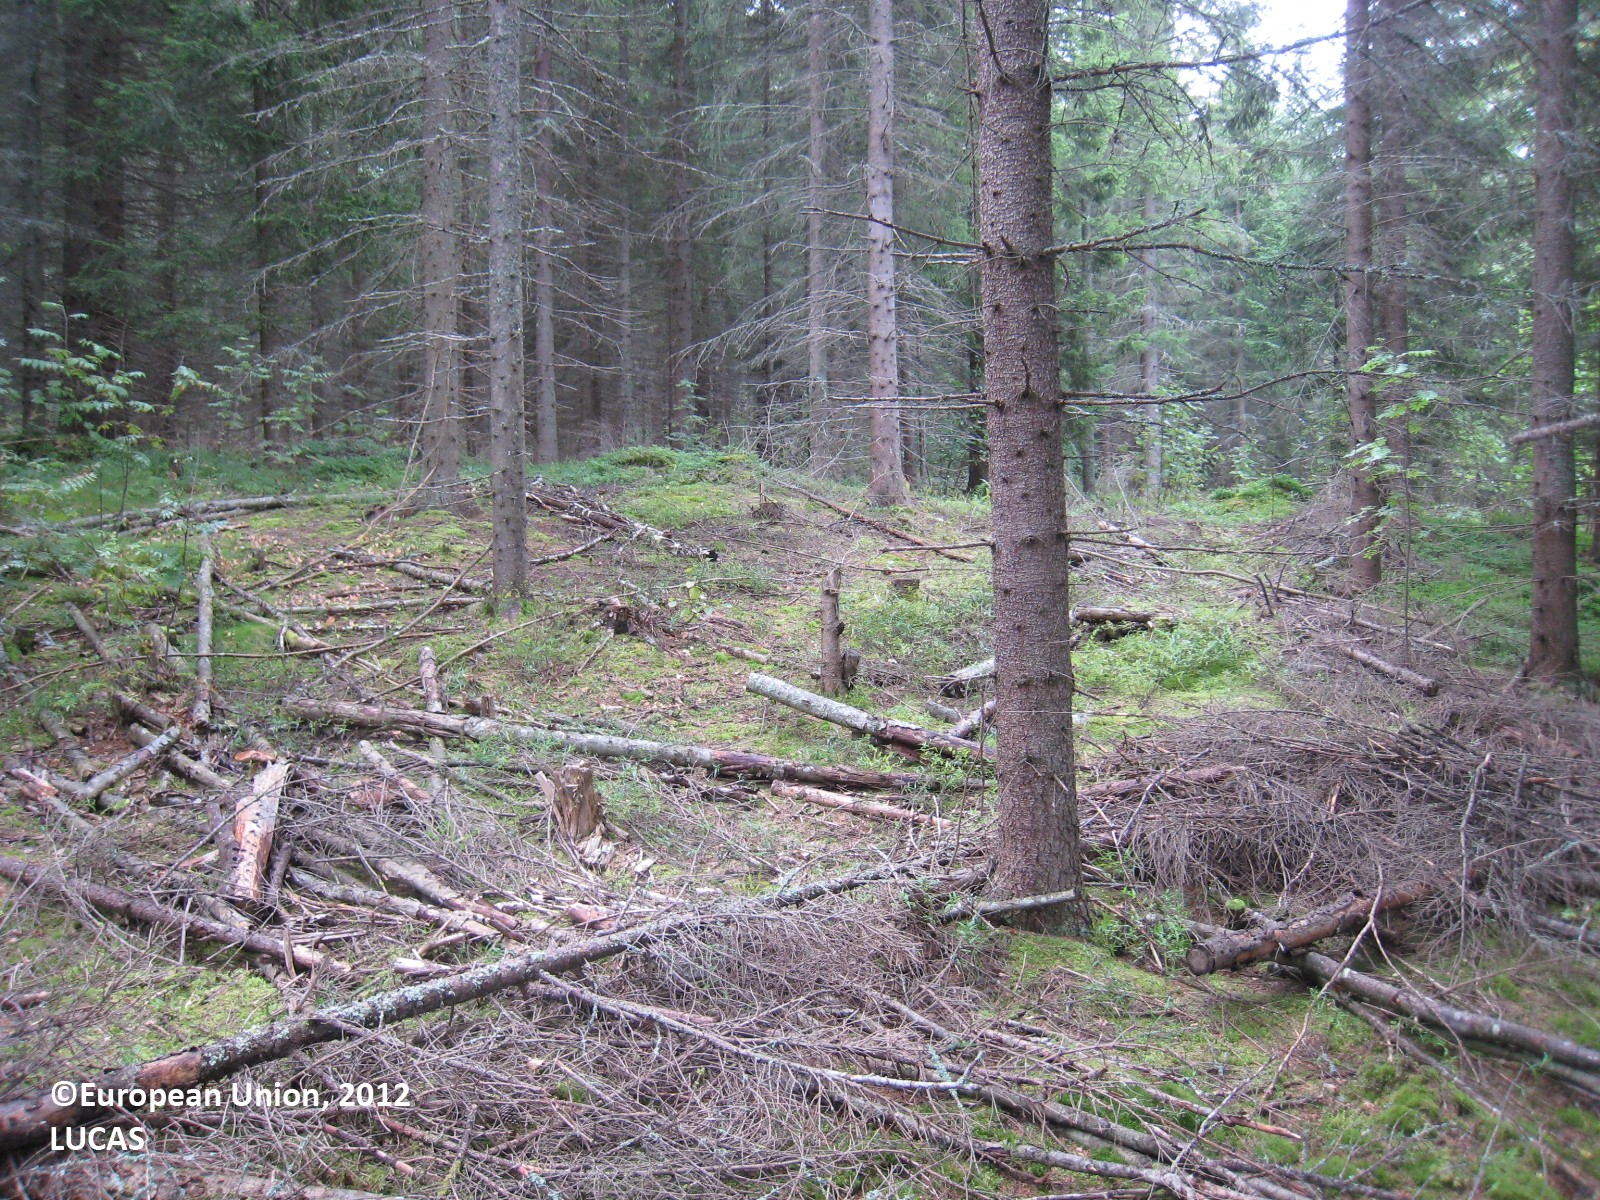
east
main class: Woodland
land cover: Spruce dominated coniferous woodland
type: boreal forest
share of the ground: 50 - 75 %
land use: Forestry
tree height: > 5 m
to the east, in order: Spruce dominated coniferous woodland; Dry stone walls; Broadleaved woodland; Ditches and canals; Broadleaved woodland; Ditches and canals; Broadleaved woodland; Spruce dominated coniferous woodland; Dry stone walls; Broadleaved woodland
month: August
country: FI
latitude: 61.8292
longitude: 26.1020
